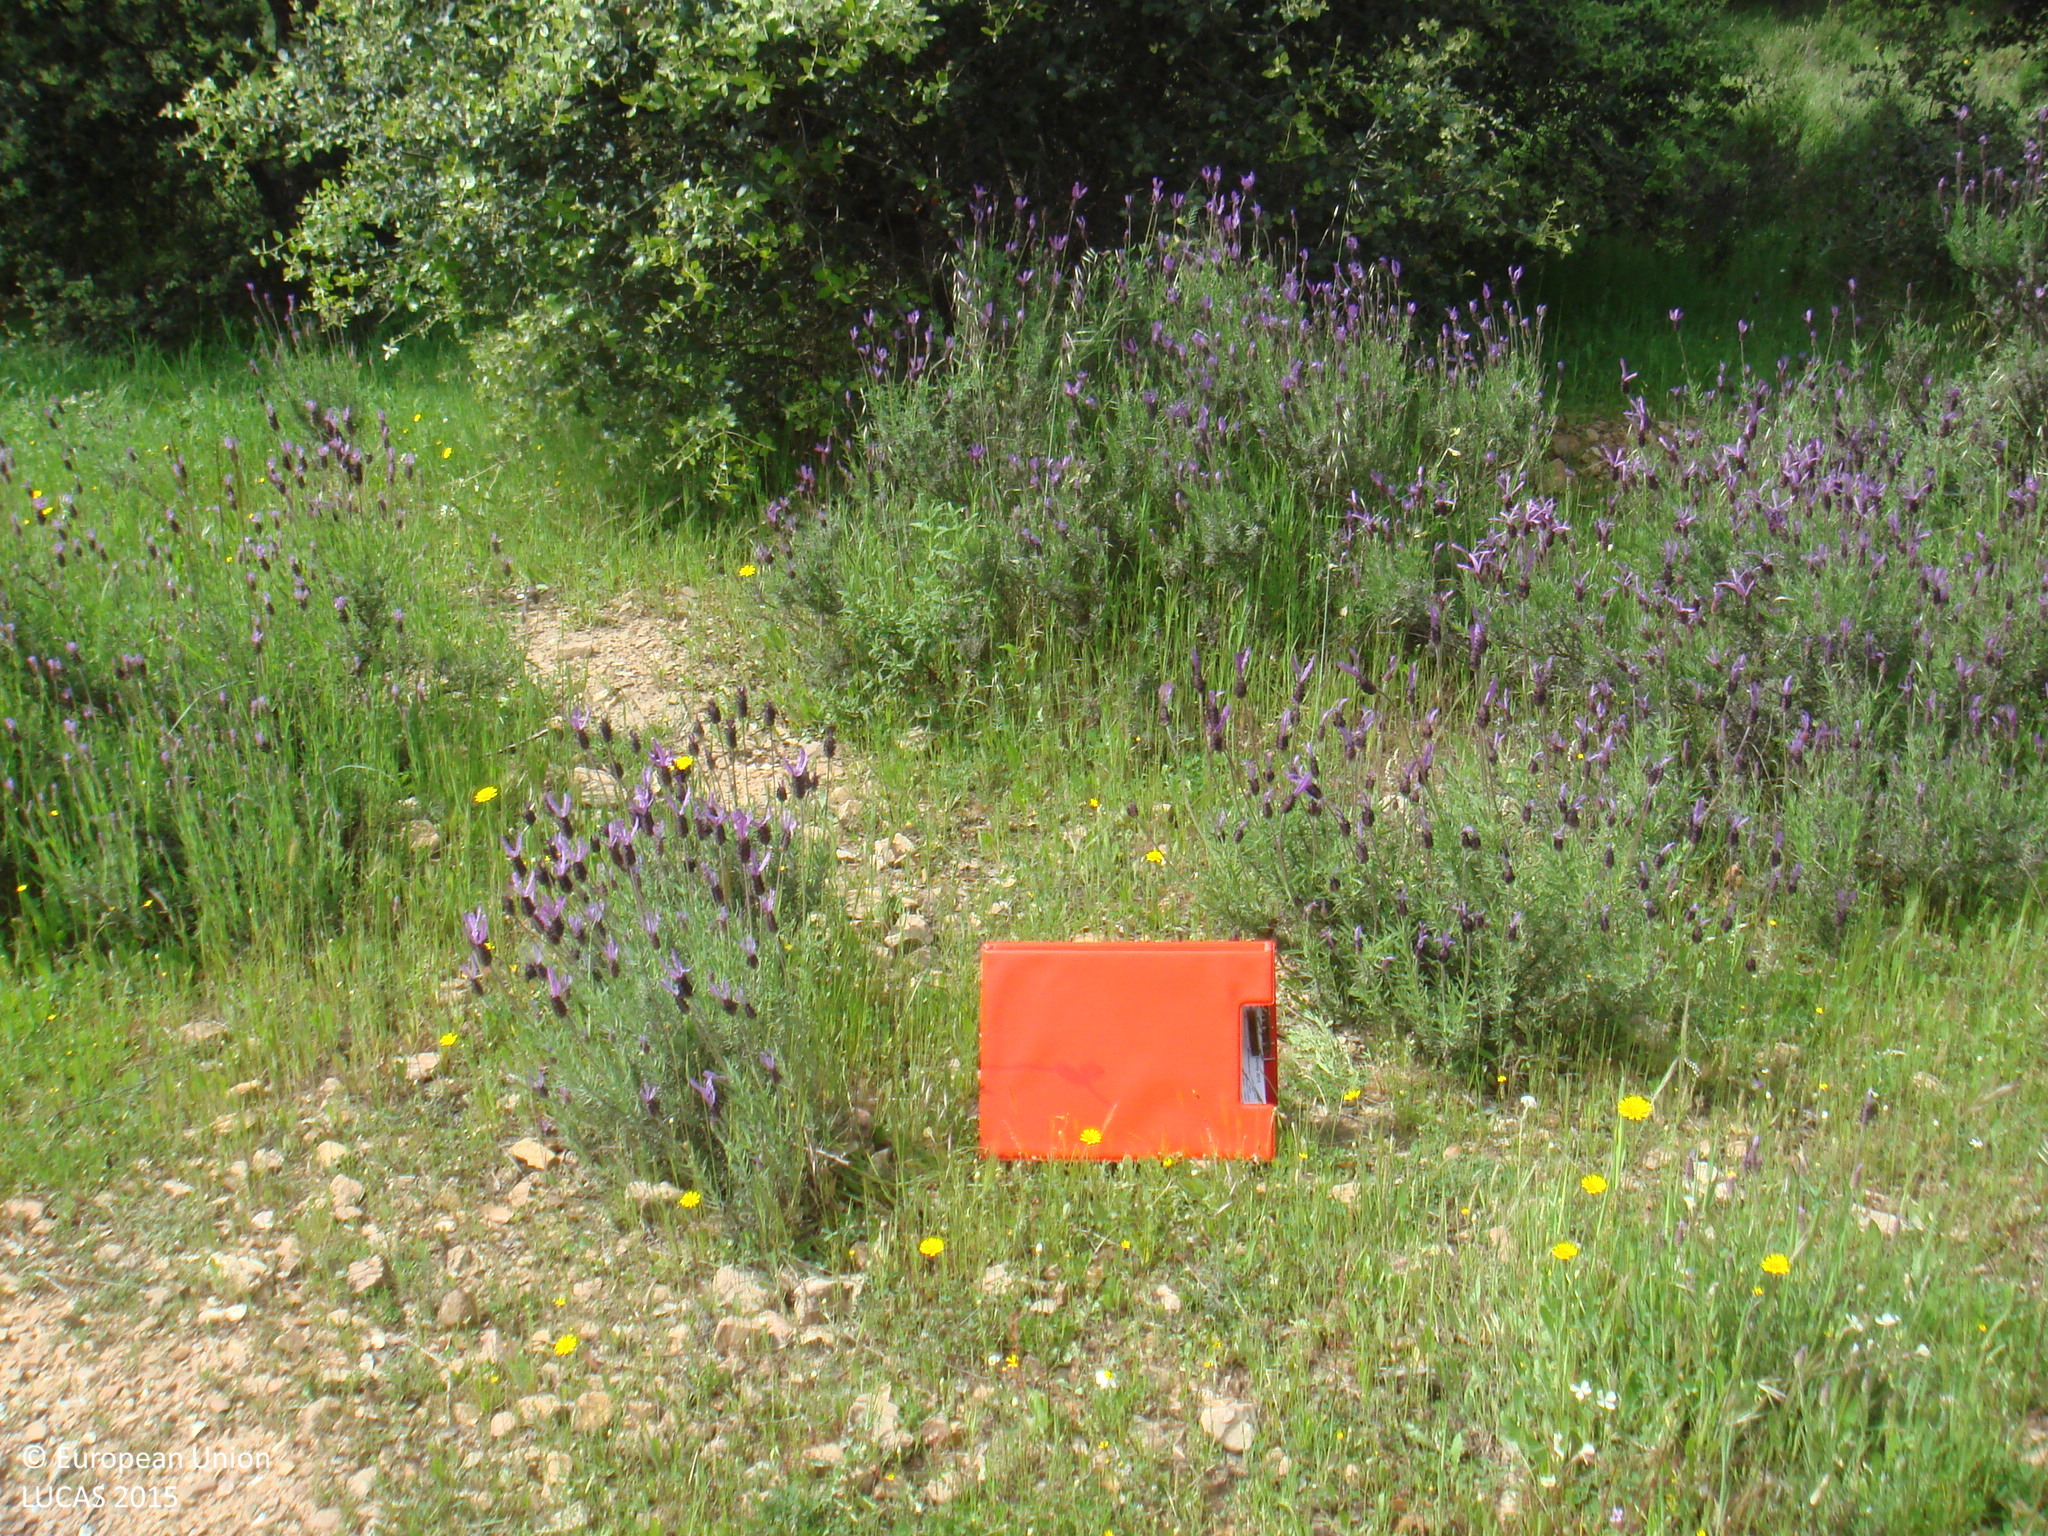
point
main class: Woodland
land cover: Broadleaved woodland
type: broadleaved evergreen forest
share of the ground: 25 - 50 %
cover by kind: broadleaved forest trees 30 %, shrubs 30 %, herbaceous plants 30 %, consolidated bare surface 10 %
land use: Forestry
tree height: > 5 m
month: April
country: ES
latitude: 38.2529
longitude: -5.2834
